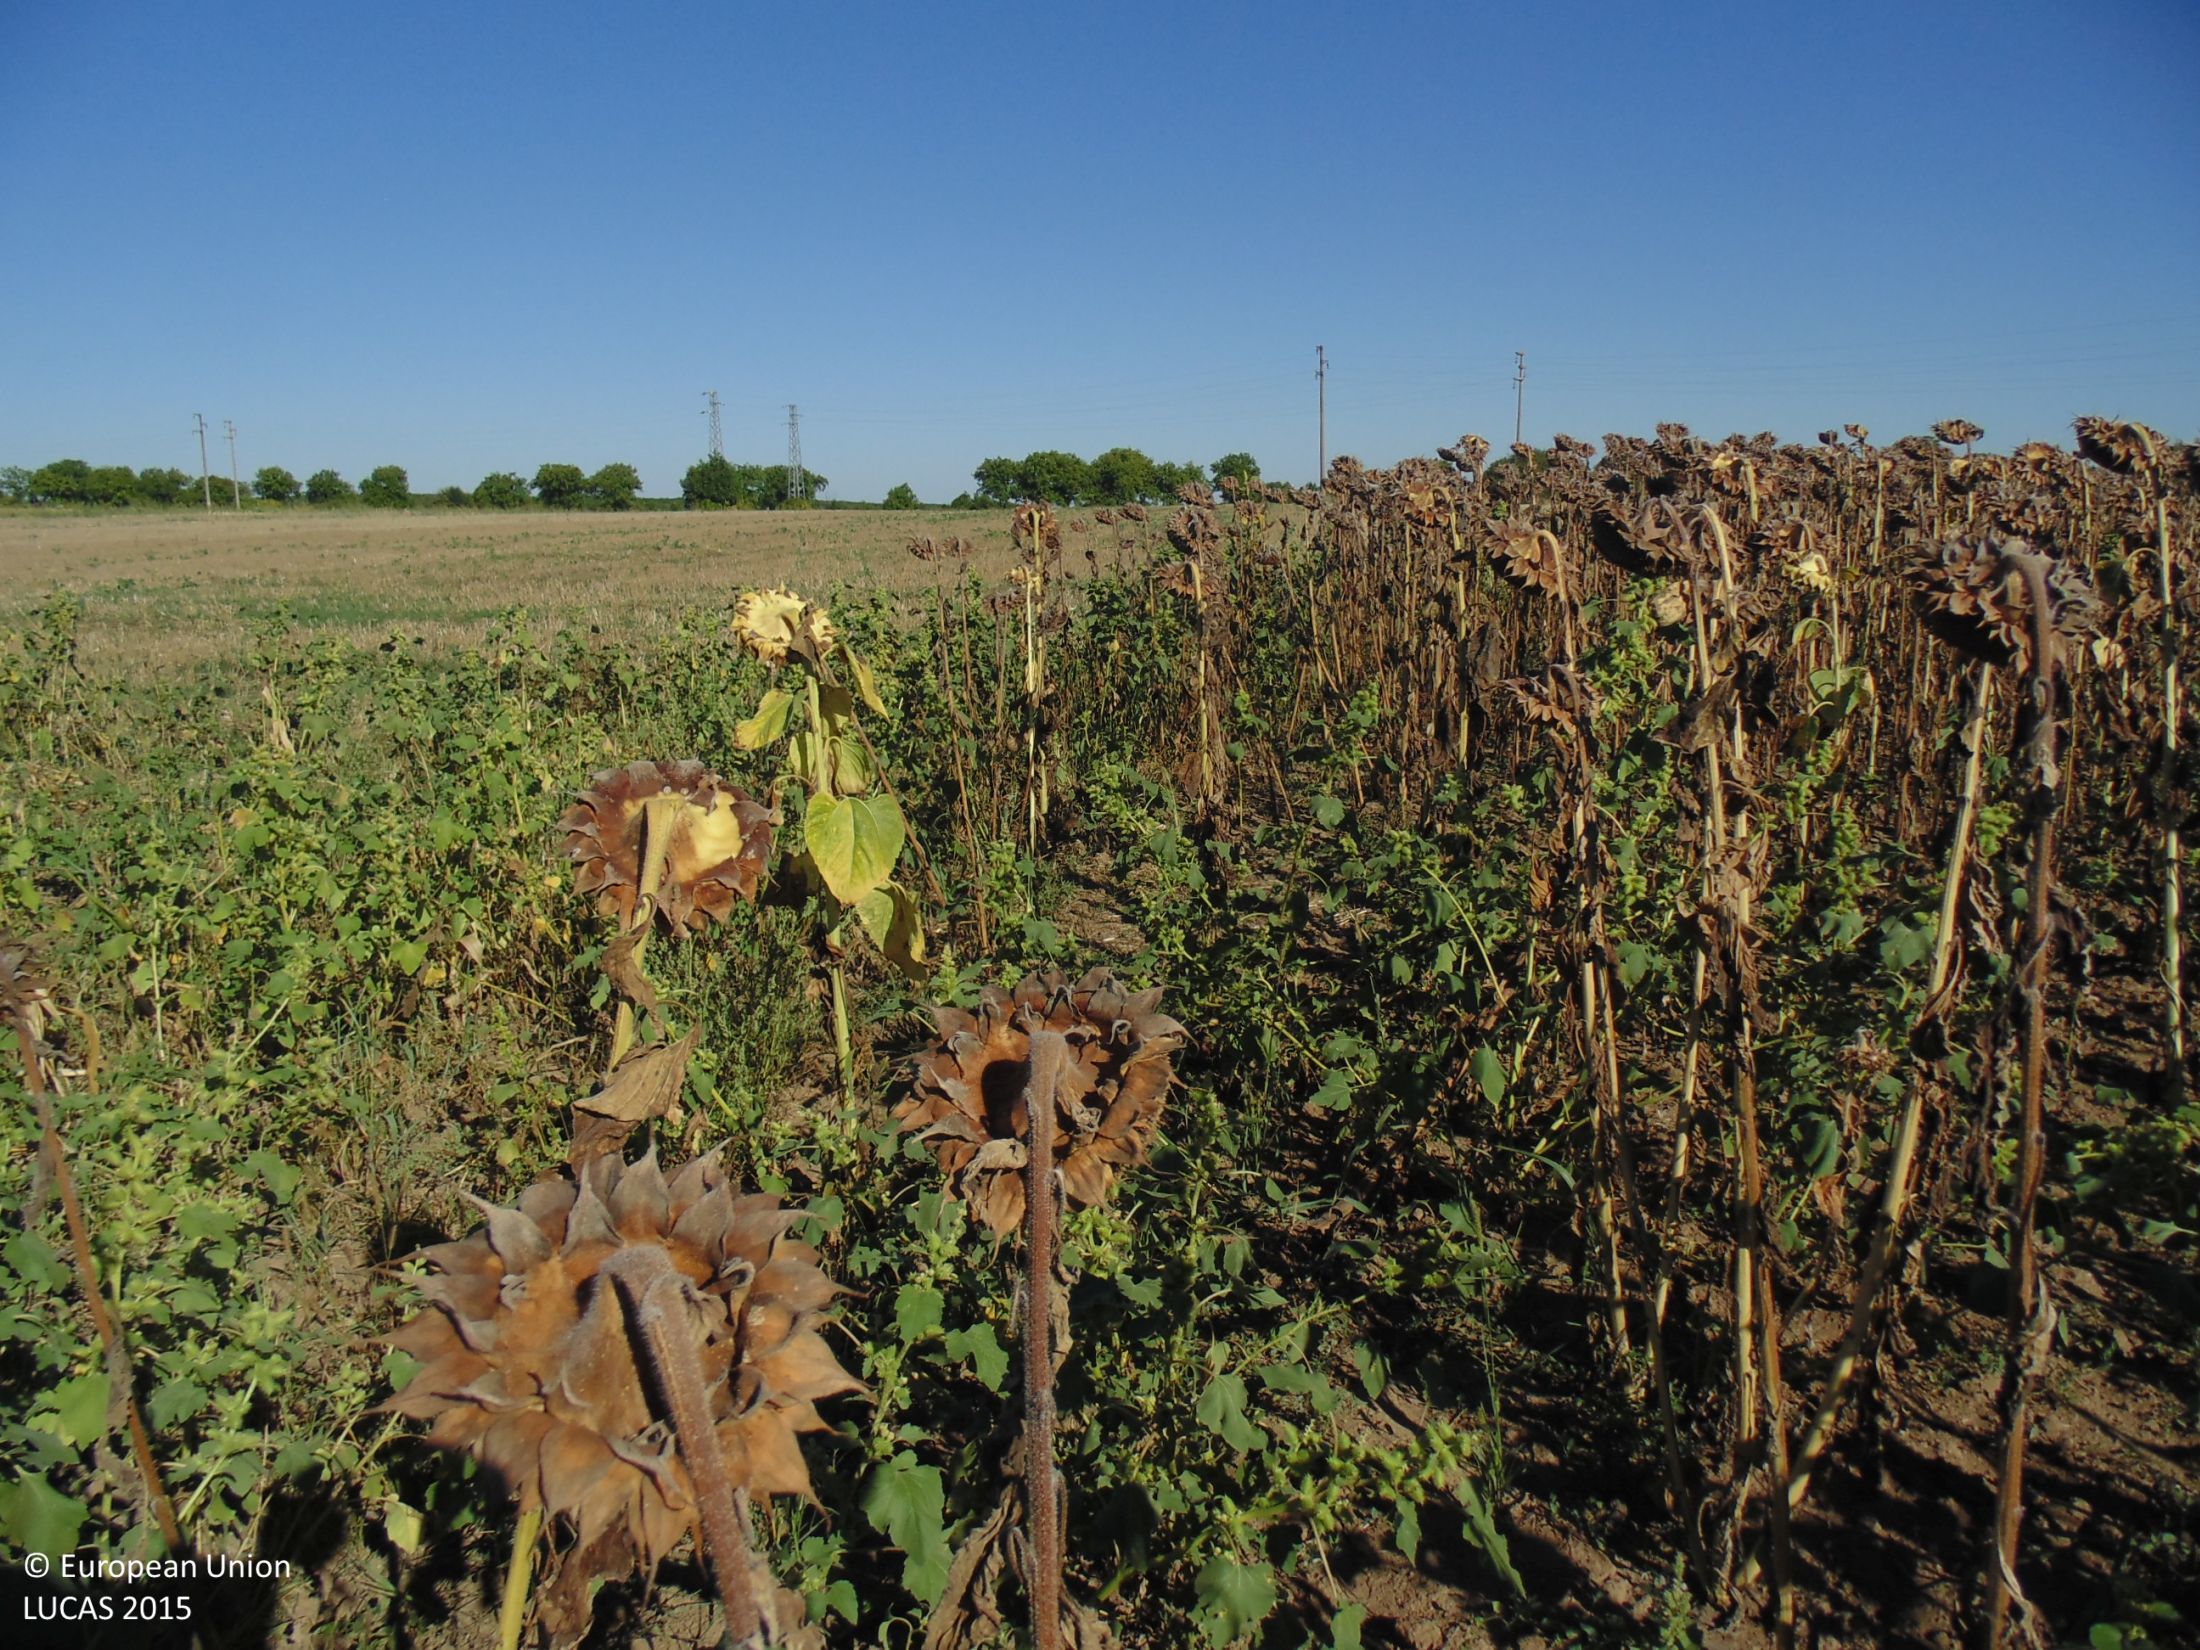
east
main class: Cropland
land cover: Sunflower
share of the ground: > 75 %
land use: Agriculture (excluding fallow land and kitchen gardens)
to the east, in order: Sunflower; Grass margins; Common wheat; Electric lines; Common wheat; Electric lines; Common wheat
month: September
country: BG
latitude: 43.8570
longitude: 27.2088
